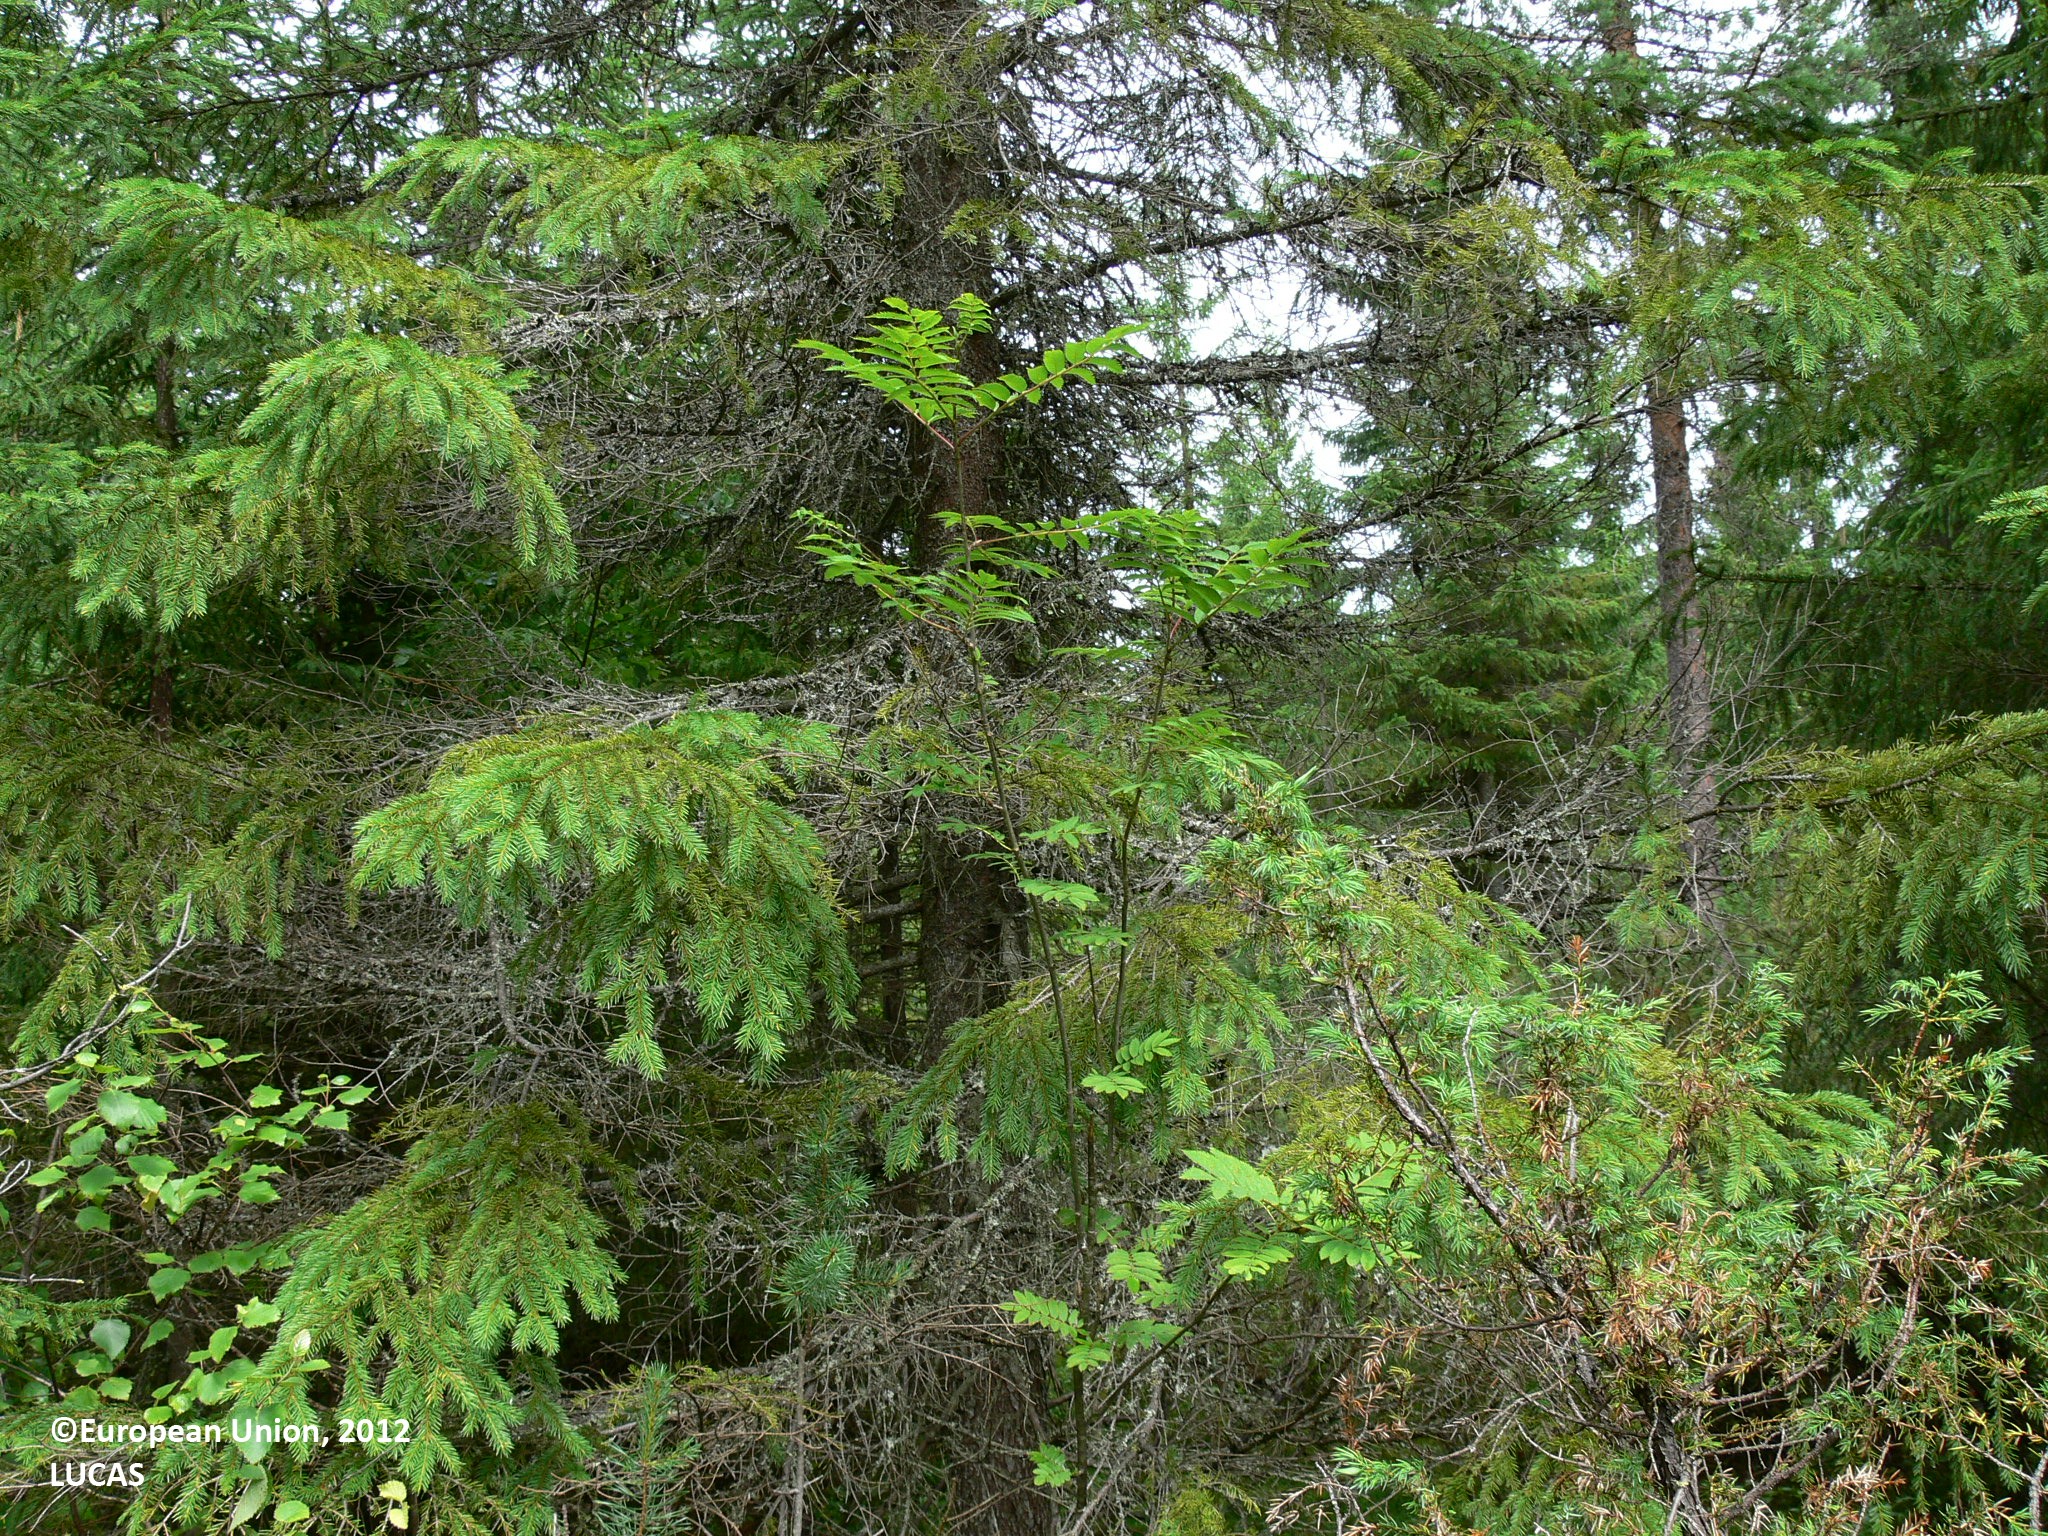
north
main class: Woodland
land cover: Spruce dominated coniferous woodland
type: boreal forest
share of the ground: 50 - 75 %
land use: Forestry
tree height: > 5 m
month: July
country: FI
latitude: 63.0872
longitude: 29.5418
